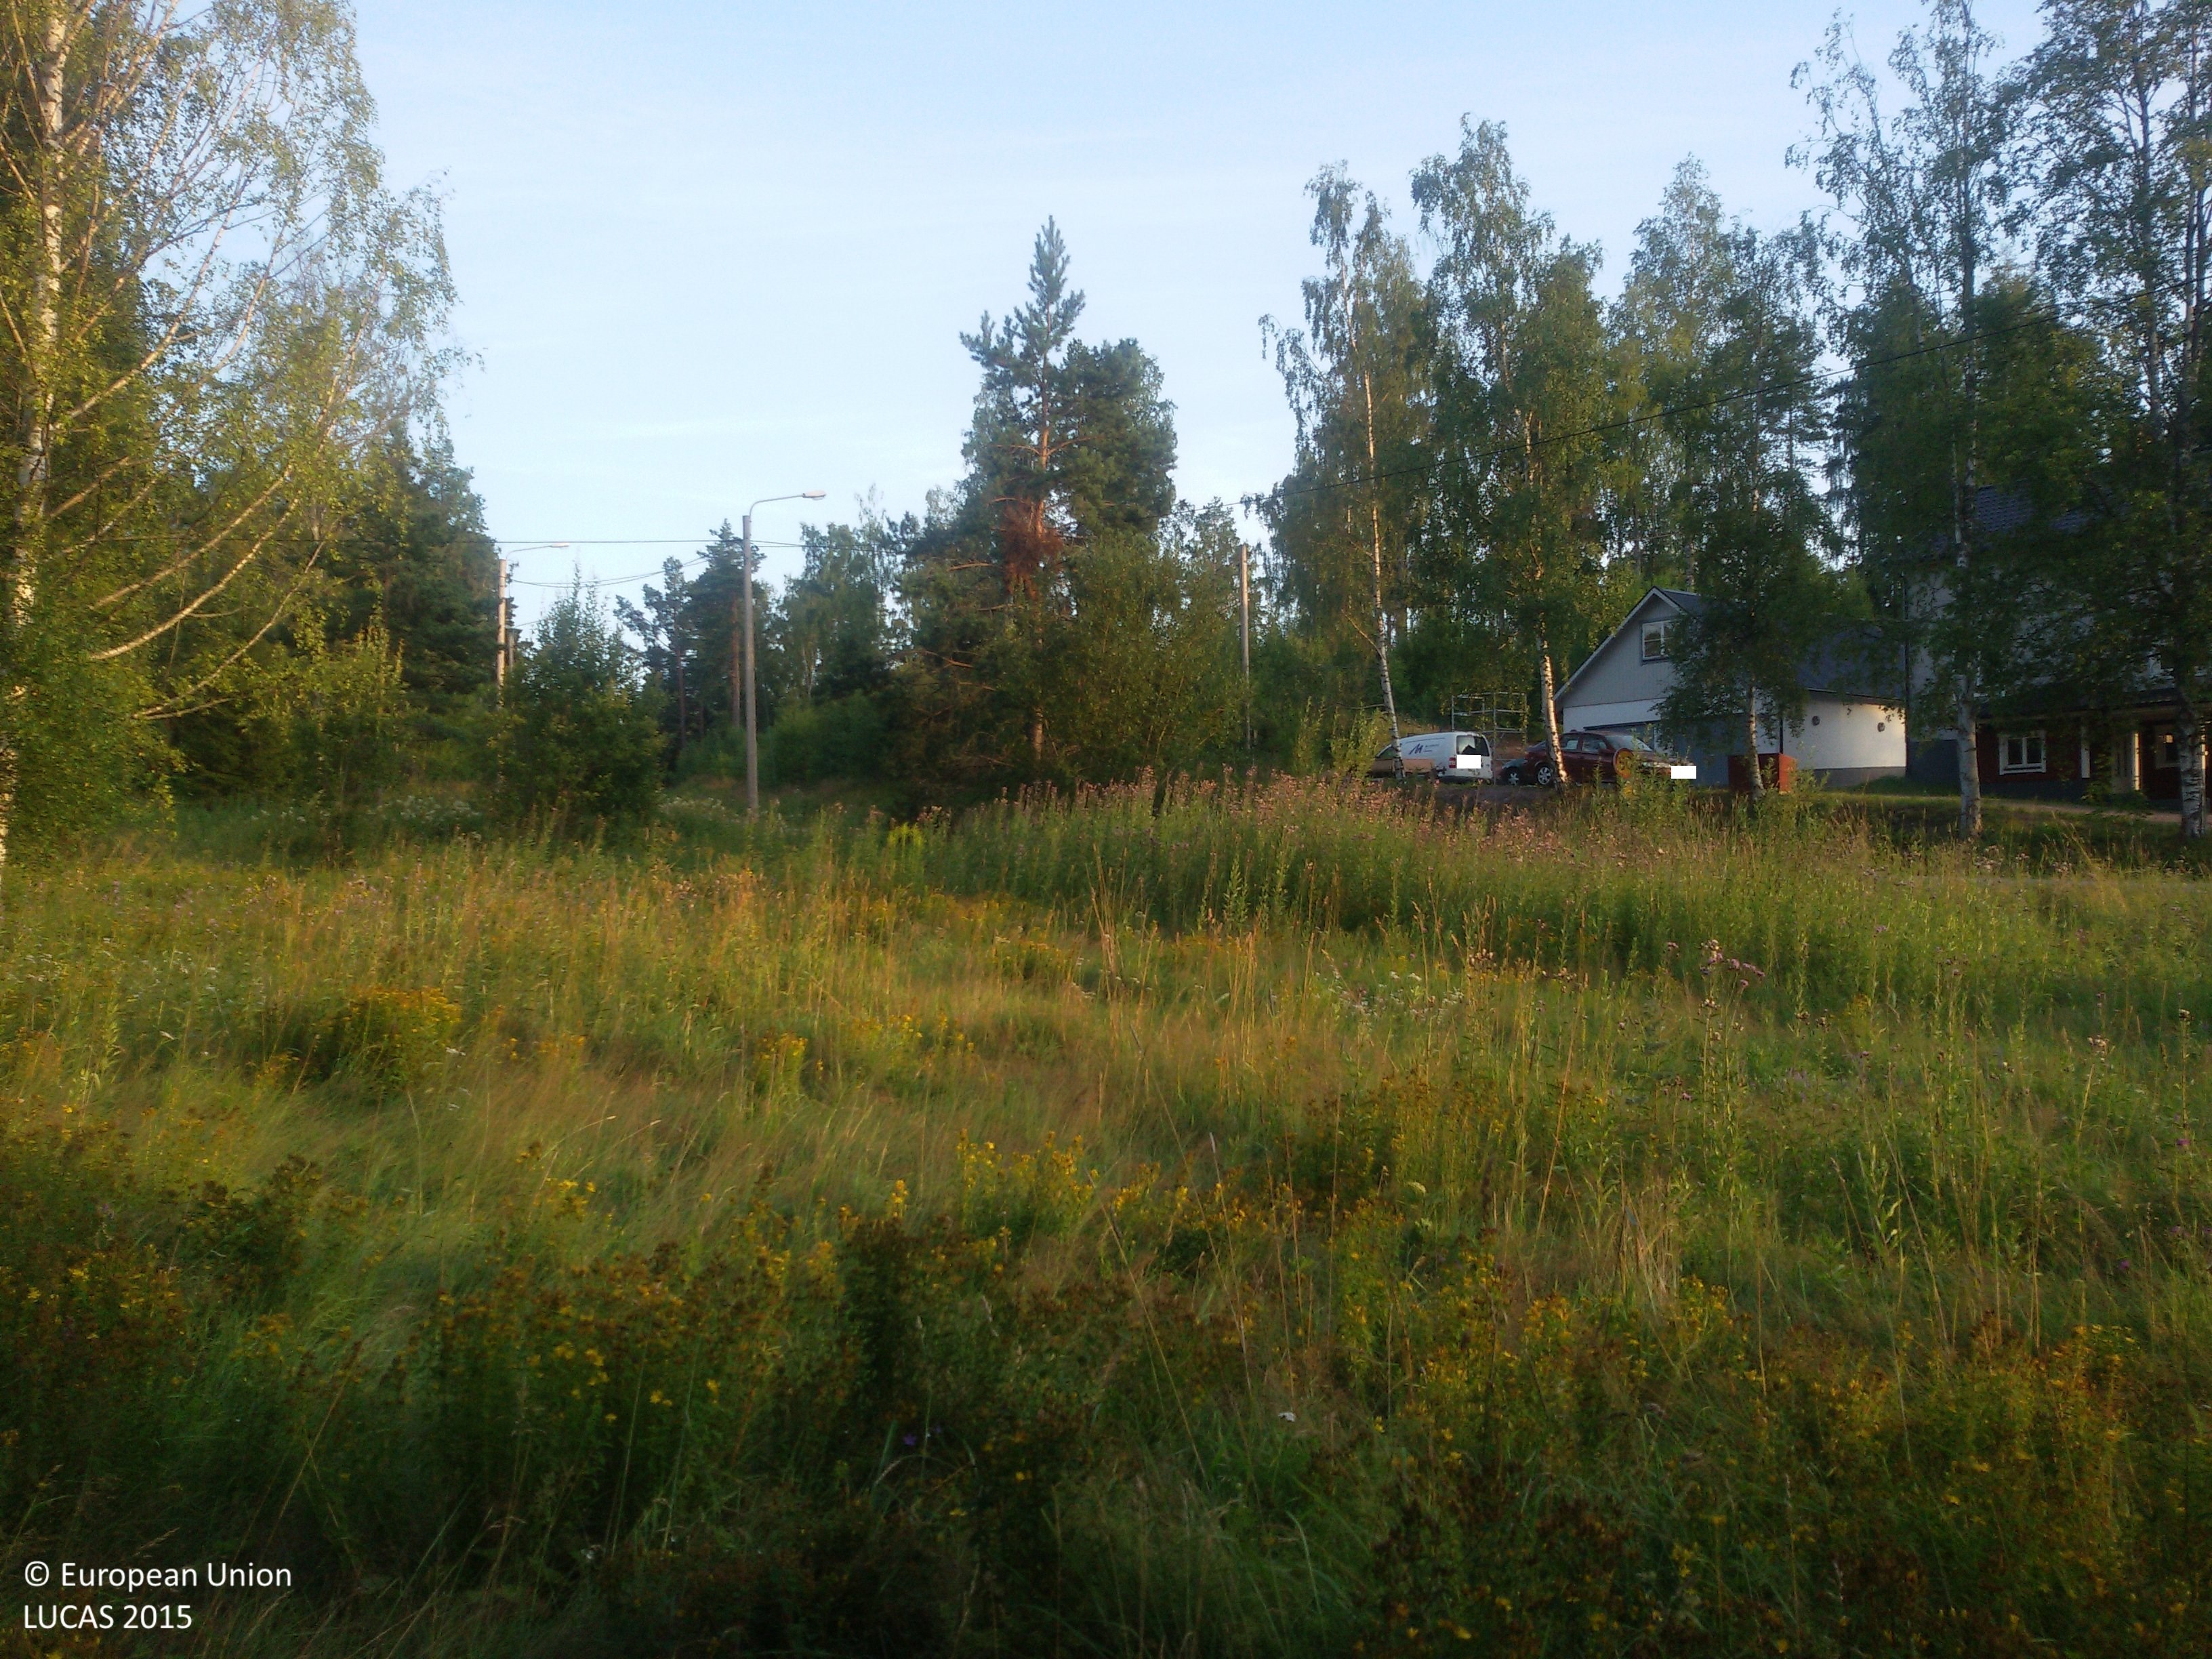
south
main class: Grassland
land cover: Grassland without tree/shrub cover
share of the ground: > 75 %
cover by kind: herbaceous plants 100 %
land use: Semi-natural and natural areas not in use
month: August
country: SE
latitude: 60.5712
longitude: 16.5384
